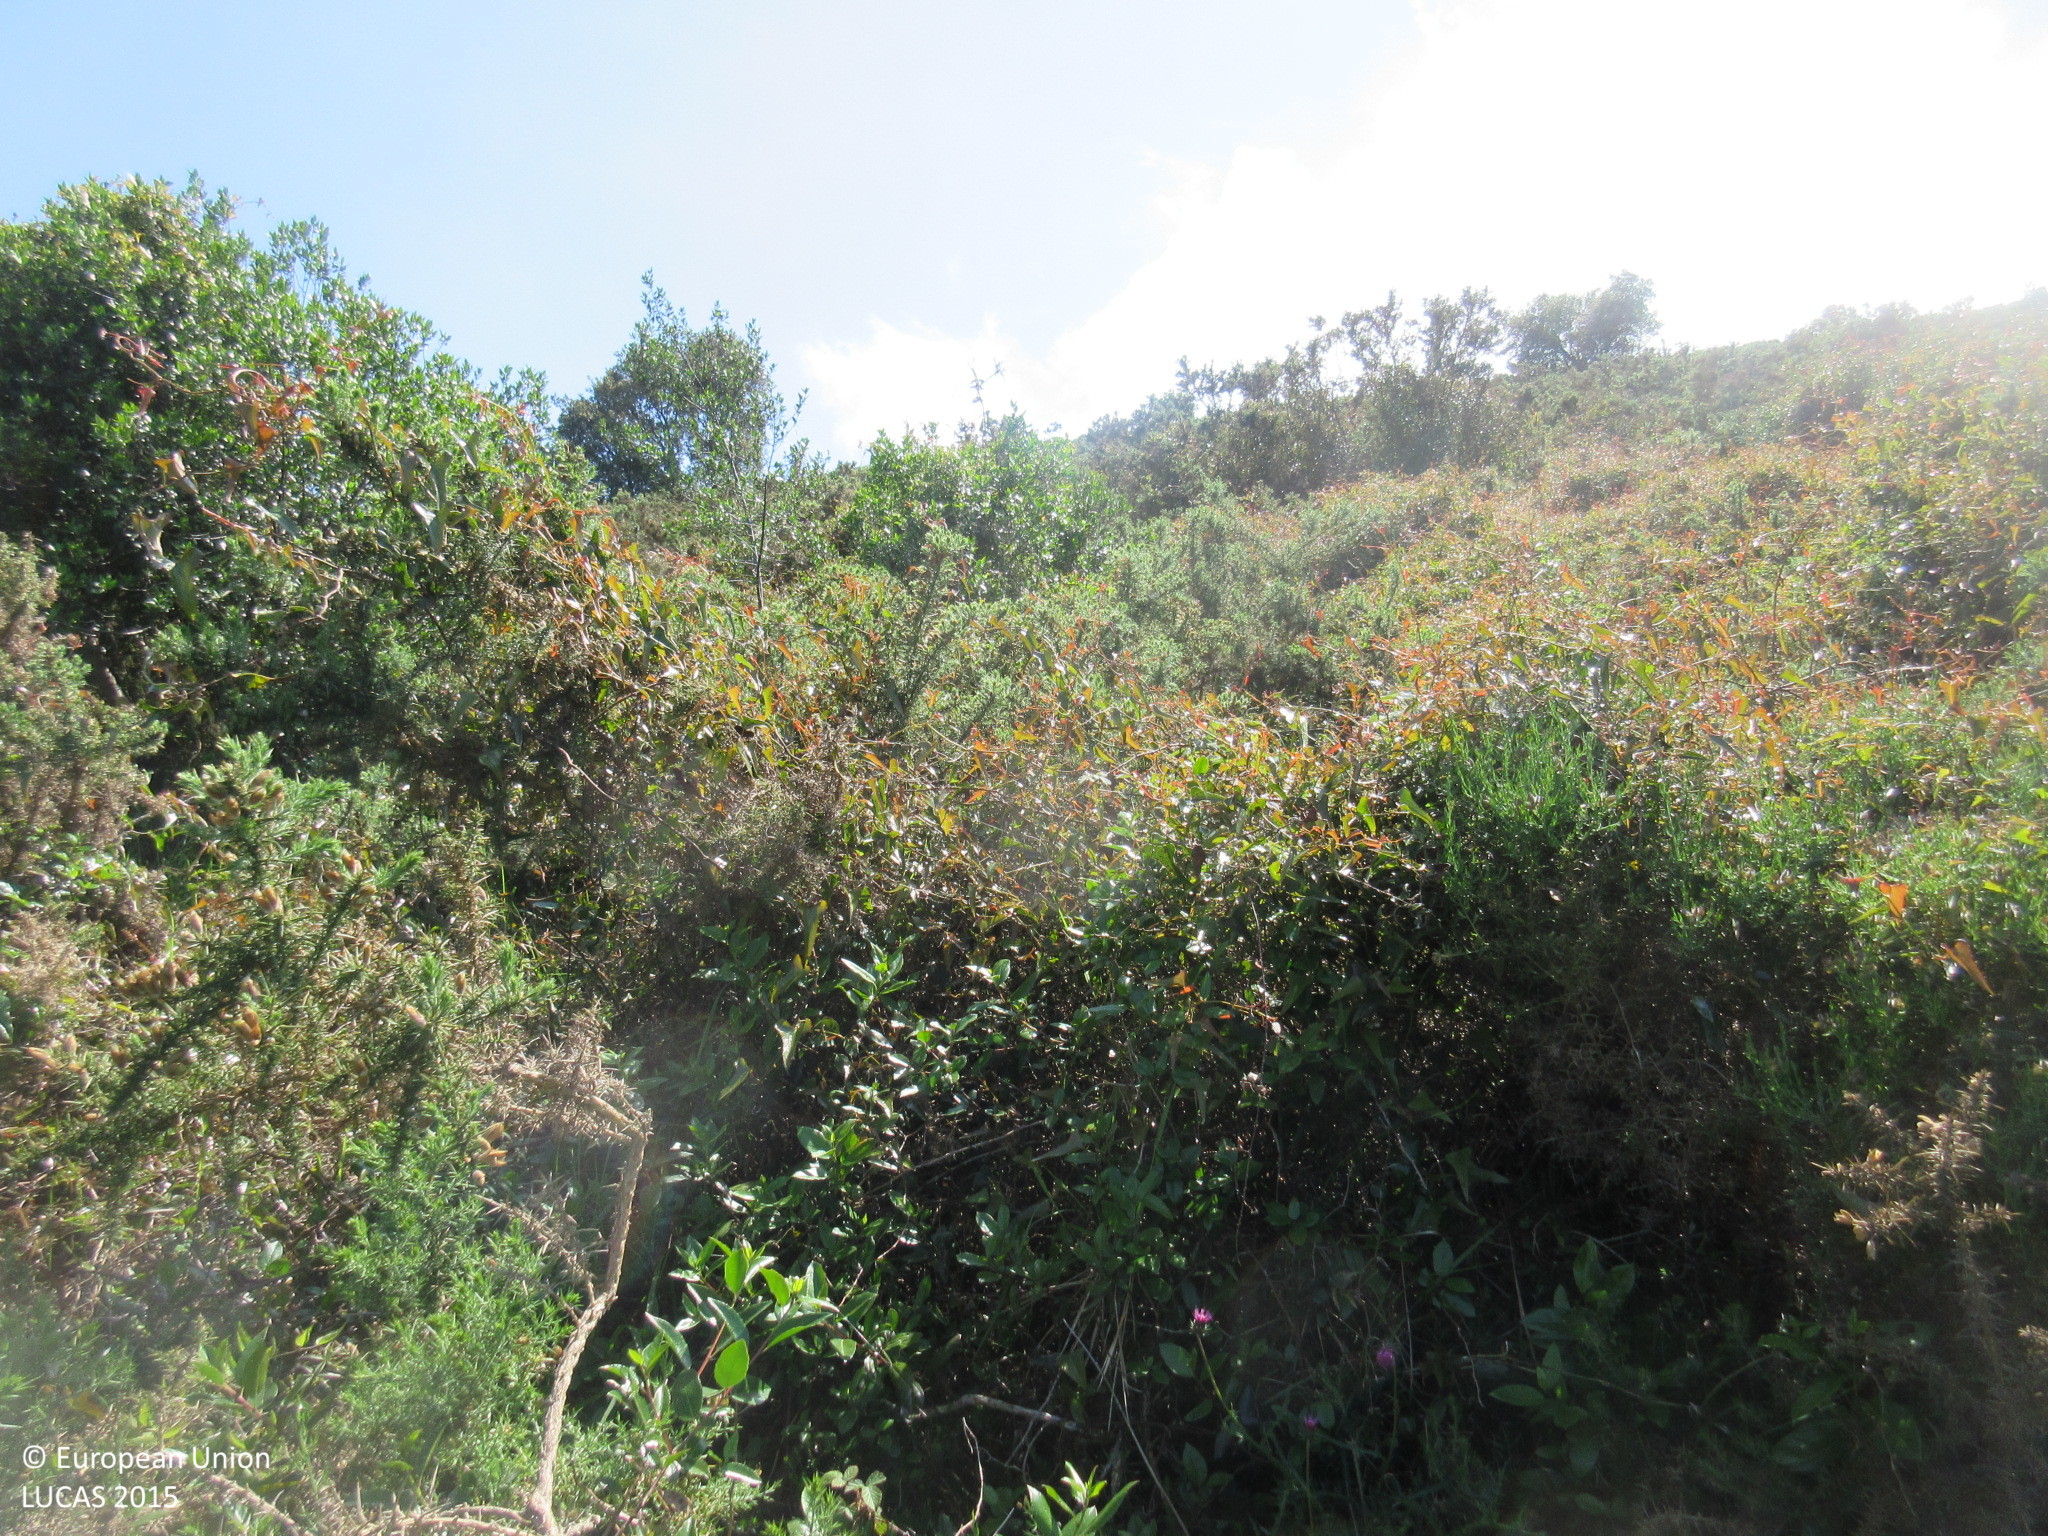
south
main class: Shrubland
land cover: Shrubland with sparse tree cover
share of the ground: > 75 %
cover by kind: shrubs 95 %, broadleaved forest trees 5 %
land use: Agriculture (excluding fallow land and kitchen gardens)
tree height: < 5 m
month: May
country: ES
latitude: 43.3433
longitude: -4.5052
